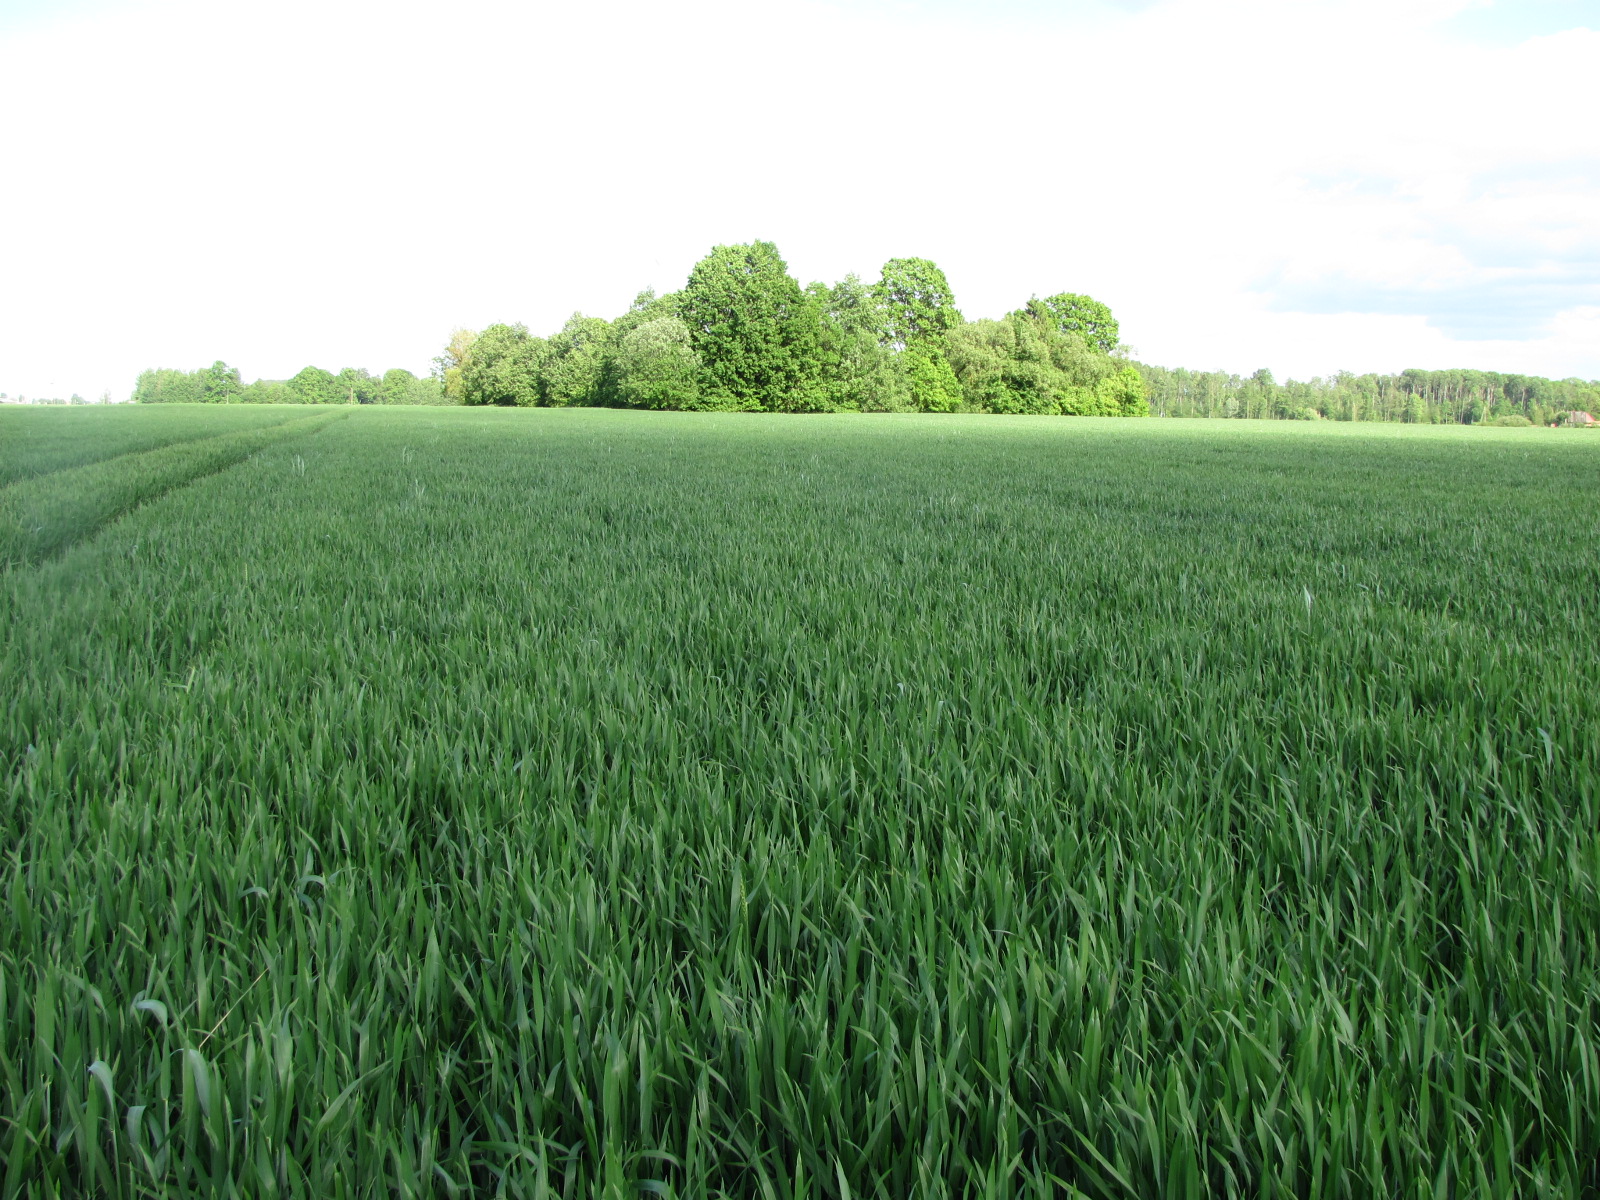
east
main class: Cropland
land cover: Common wheat
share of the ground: > 75 %
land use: Agriculture (excluding fallow land and kitchen gardens)
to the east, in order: Common wheat; Broadleaved woodland
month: June
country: LV
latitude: 56.3280
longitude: 24.1756
